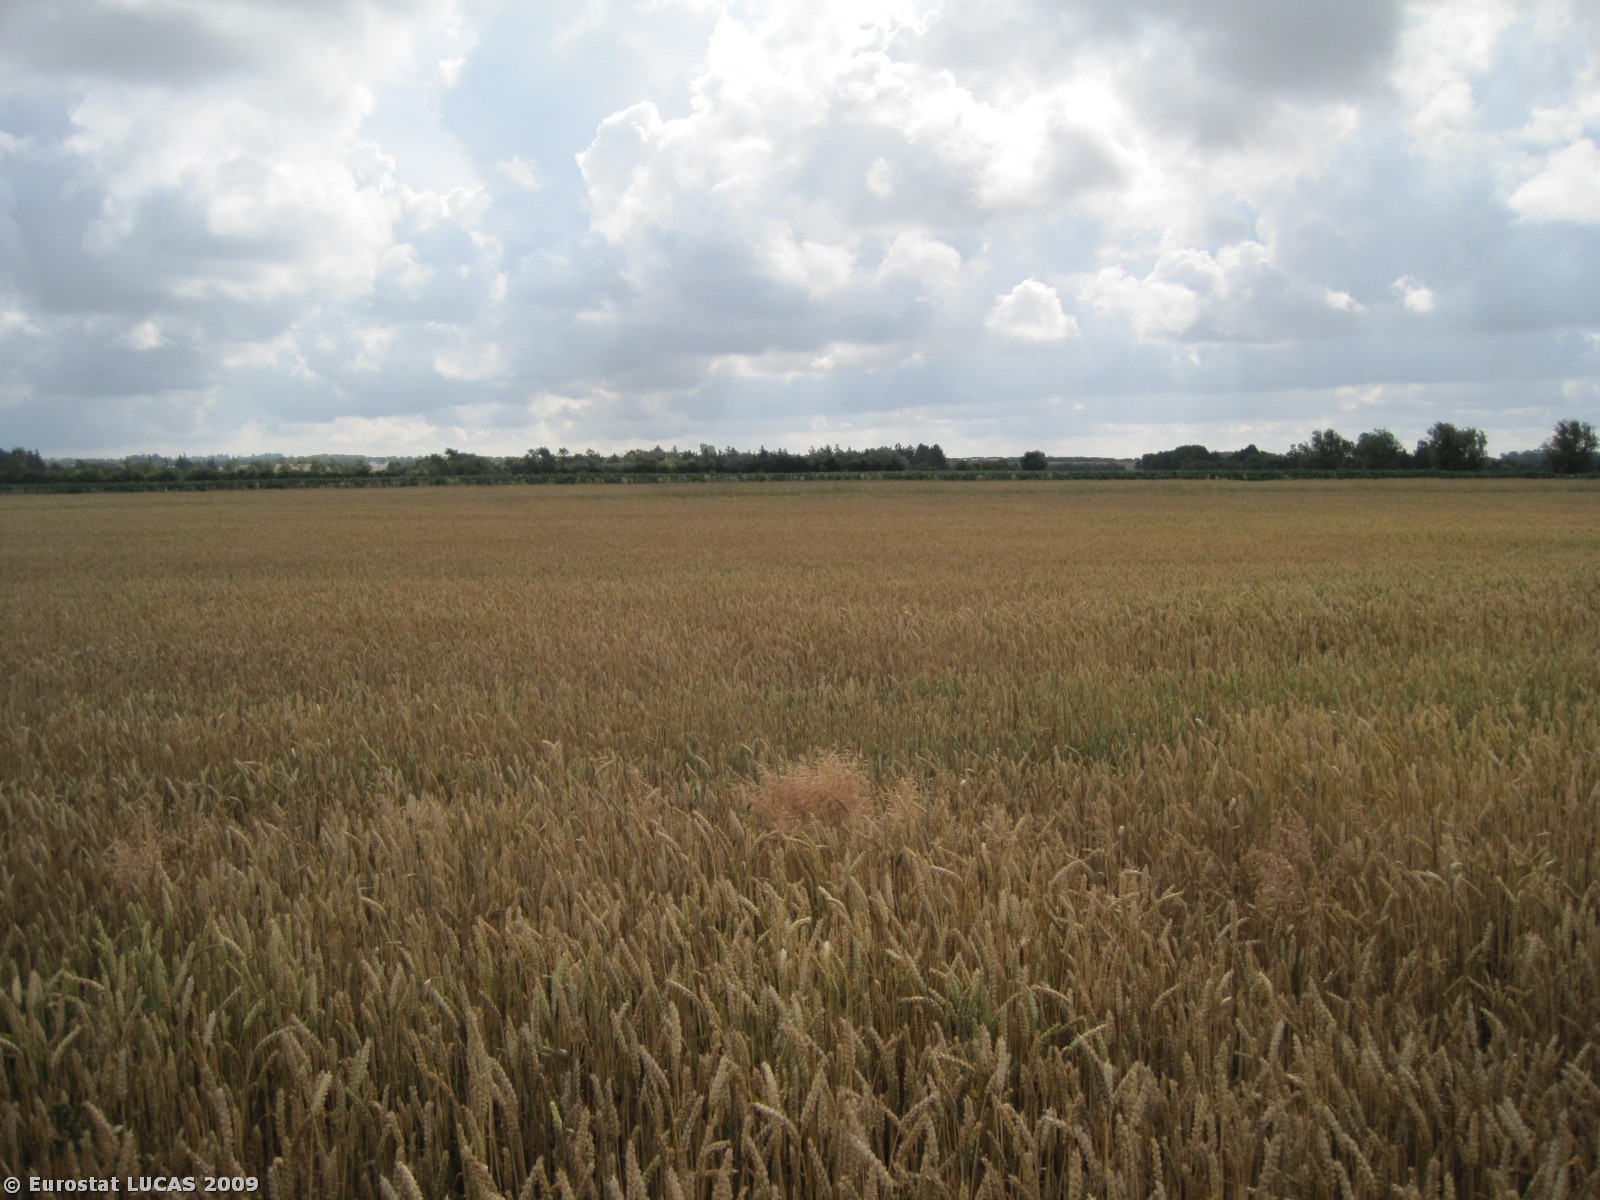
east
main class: Cropland
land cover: Common wheat
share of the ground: > 75 %
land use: Agriculture (excluding fallow land and kitchen gardens)
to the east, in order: Common wheat; Grass margins; Paved roads, cycling and walking lanes; Grass margins; Maize; Grass margins; Barley
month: July
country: DK
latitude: 57.0483
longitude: 9.2264
